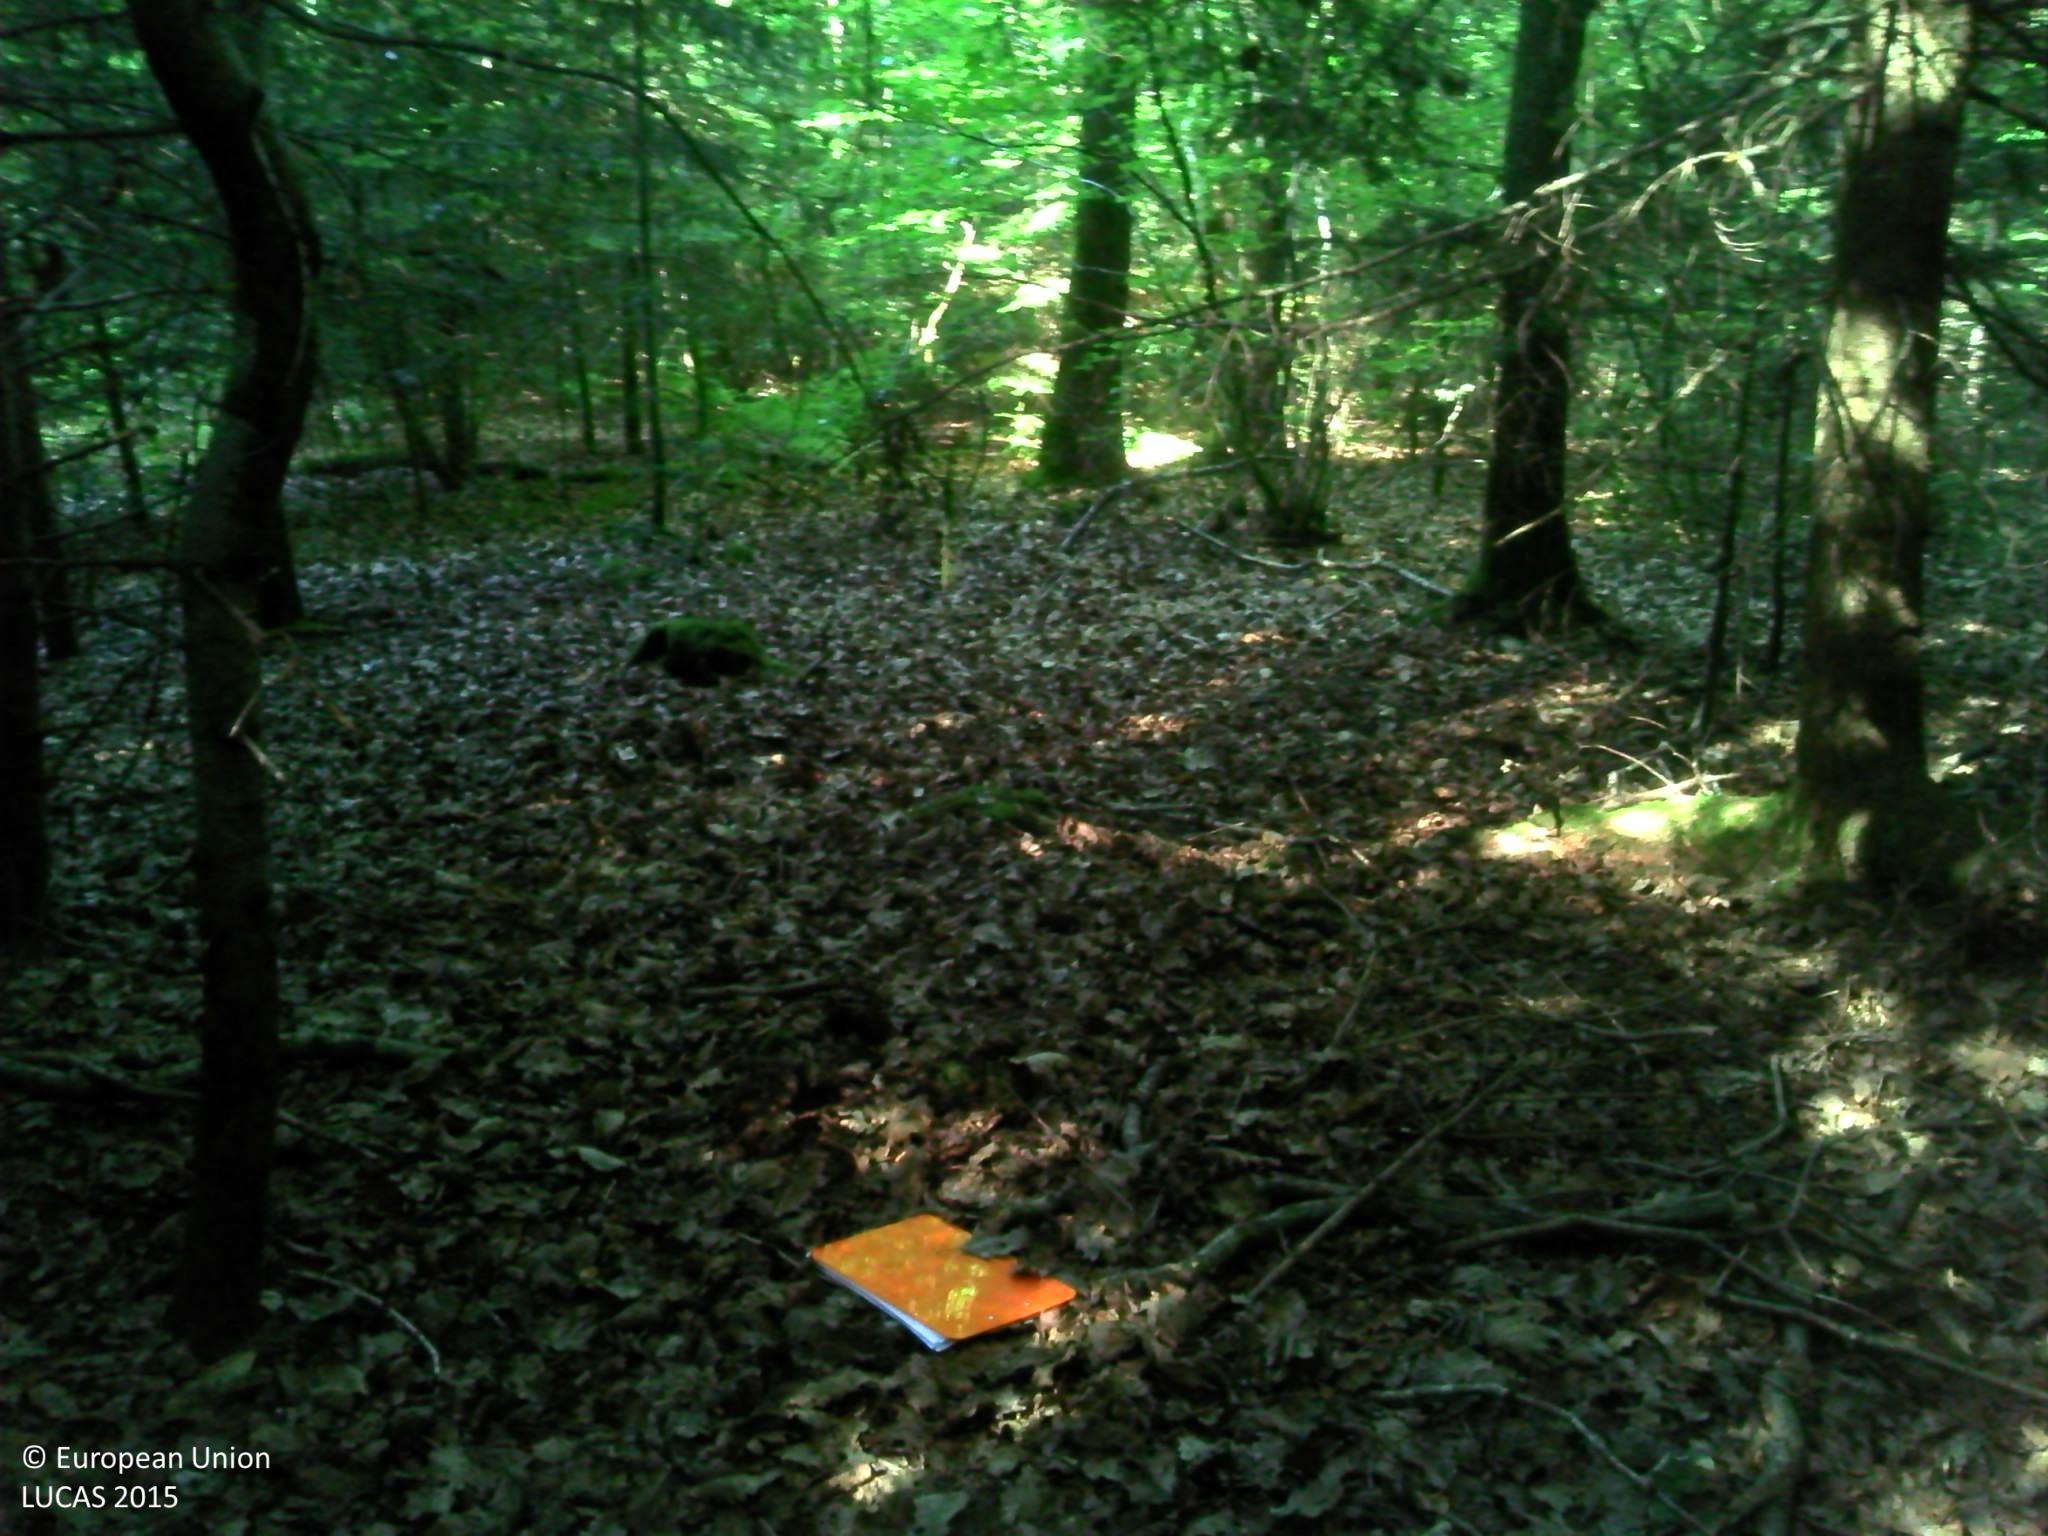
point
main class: Woodland
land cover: Spruce dominated mixed woodland
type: mesophytic deciduous forest
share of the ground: > 75 %
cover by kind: coniferous forest trees 40 %, broadleaved forest trees 30 %, herbaceous plants 15 %, consolidated bare surface 10 %, lichens and mosses 5 %
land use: Forestry
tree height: > 5 m
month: June
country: FR
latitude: 49.1174
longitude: 1.1697
